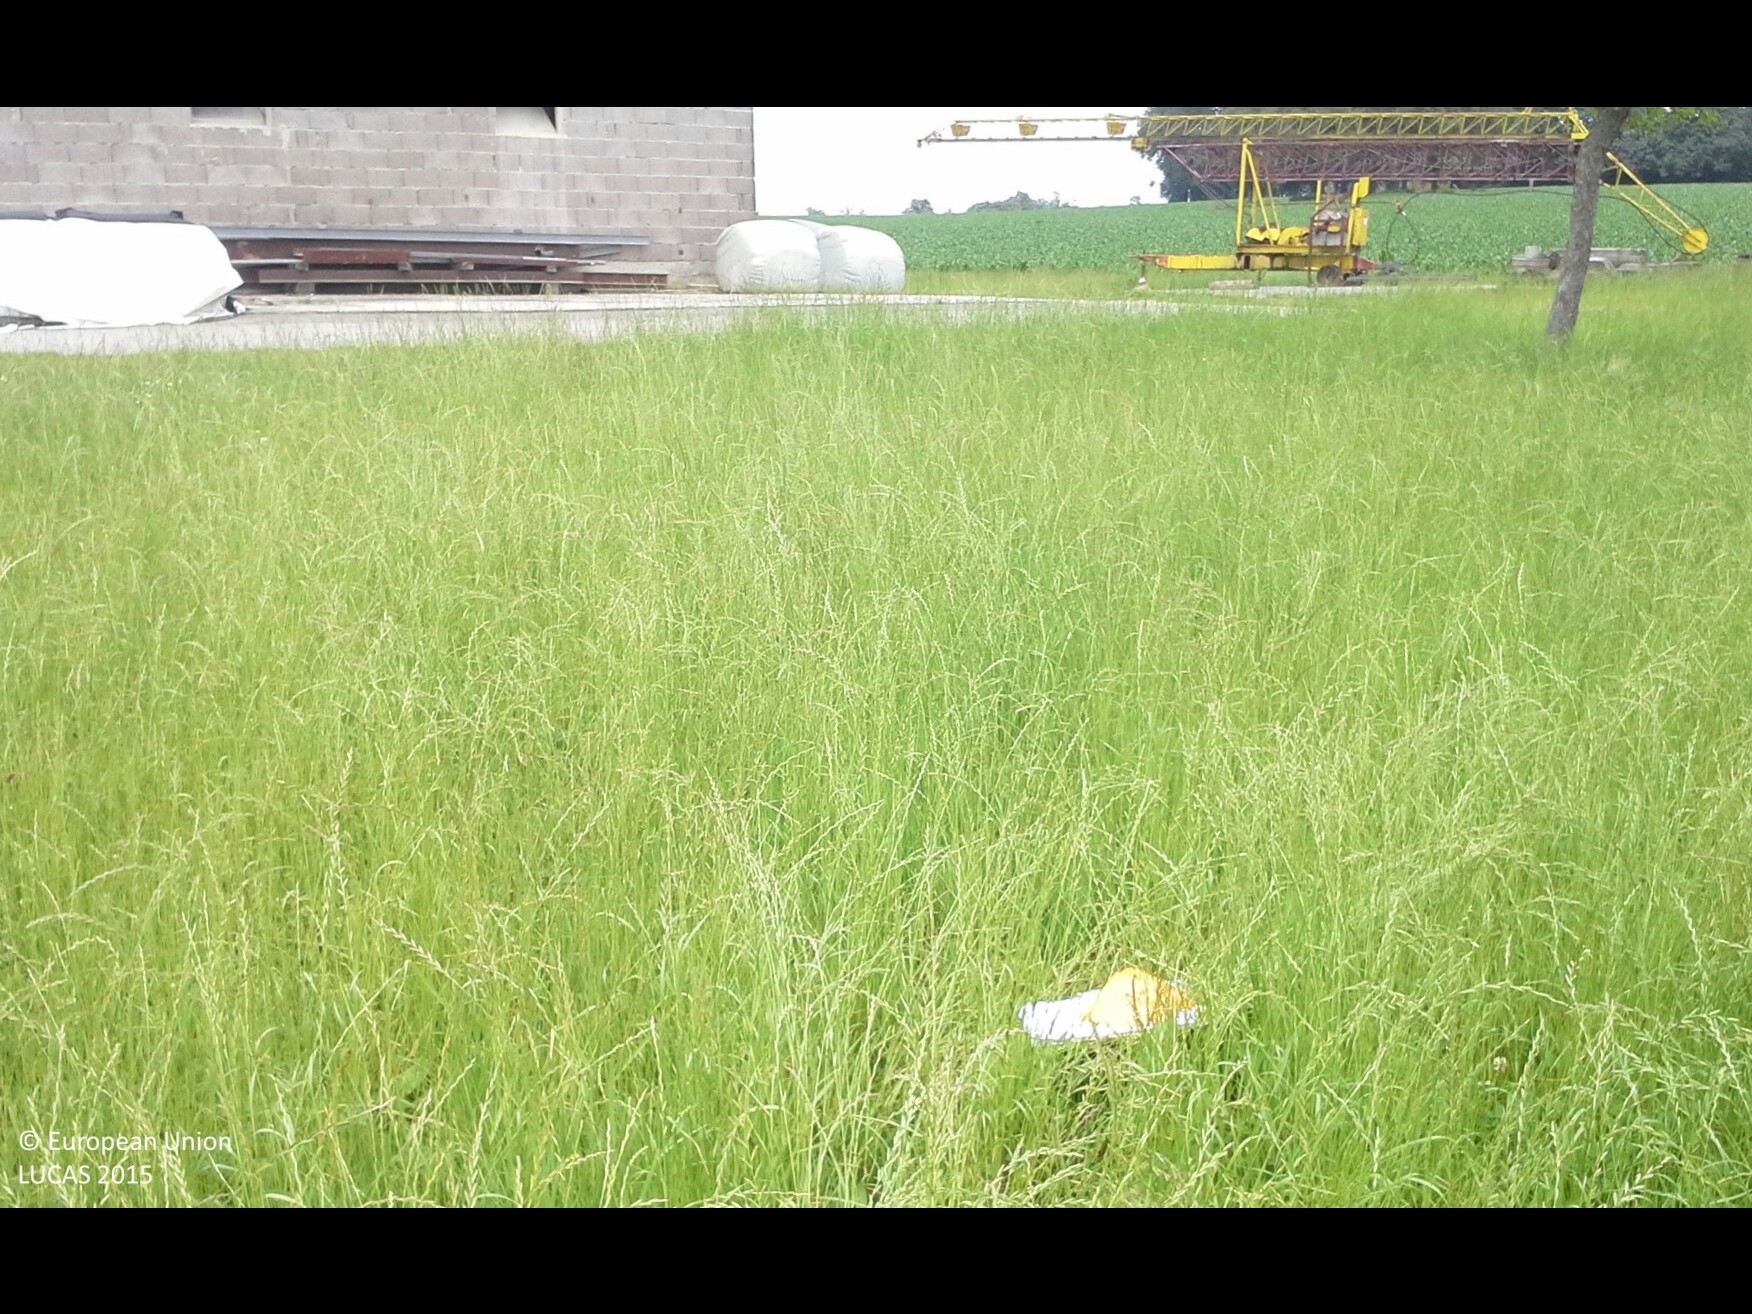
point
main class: Grassland
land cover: Grassland with sparse tree/shrub cover
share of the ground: > 75 %
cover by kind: herbaceous plants 95 %, broadleaved forest trees 5 %
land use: Agriculture (excluding fallow land and kitchen gardens)
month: June
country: AT
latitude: 48.0565
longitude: 14.5755
